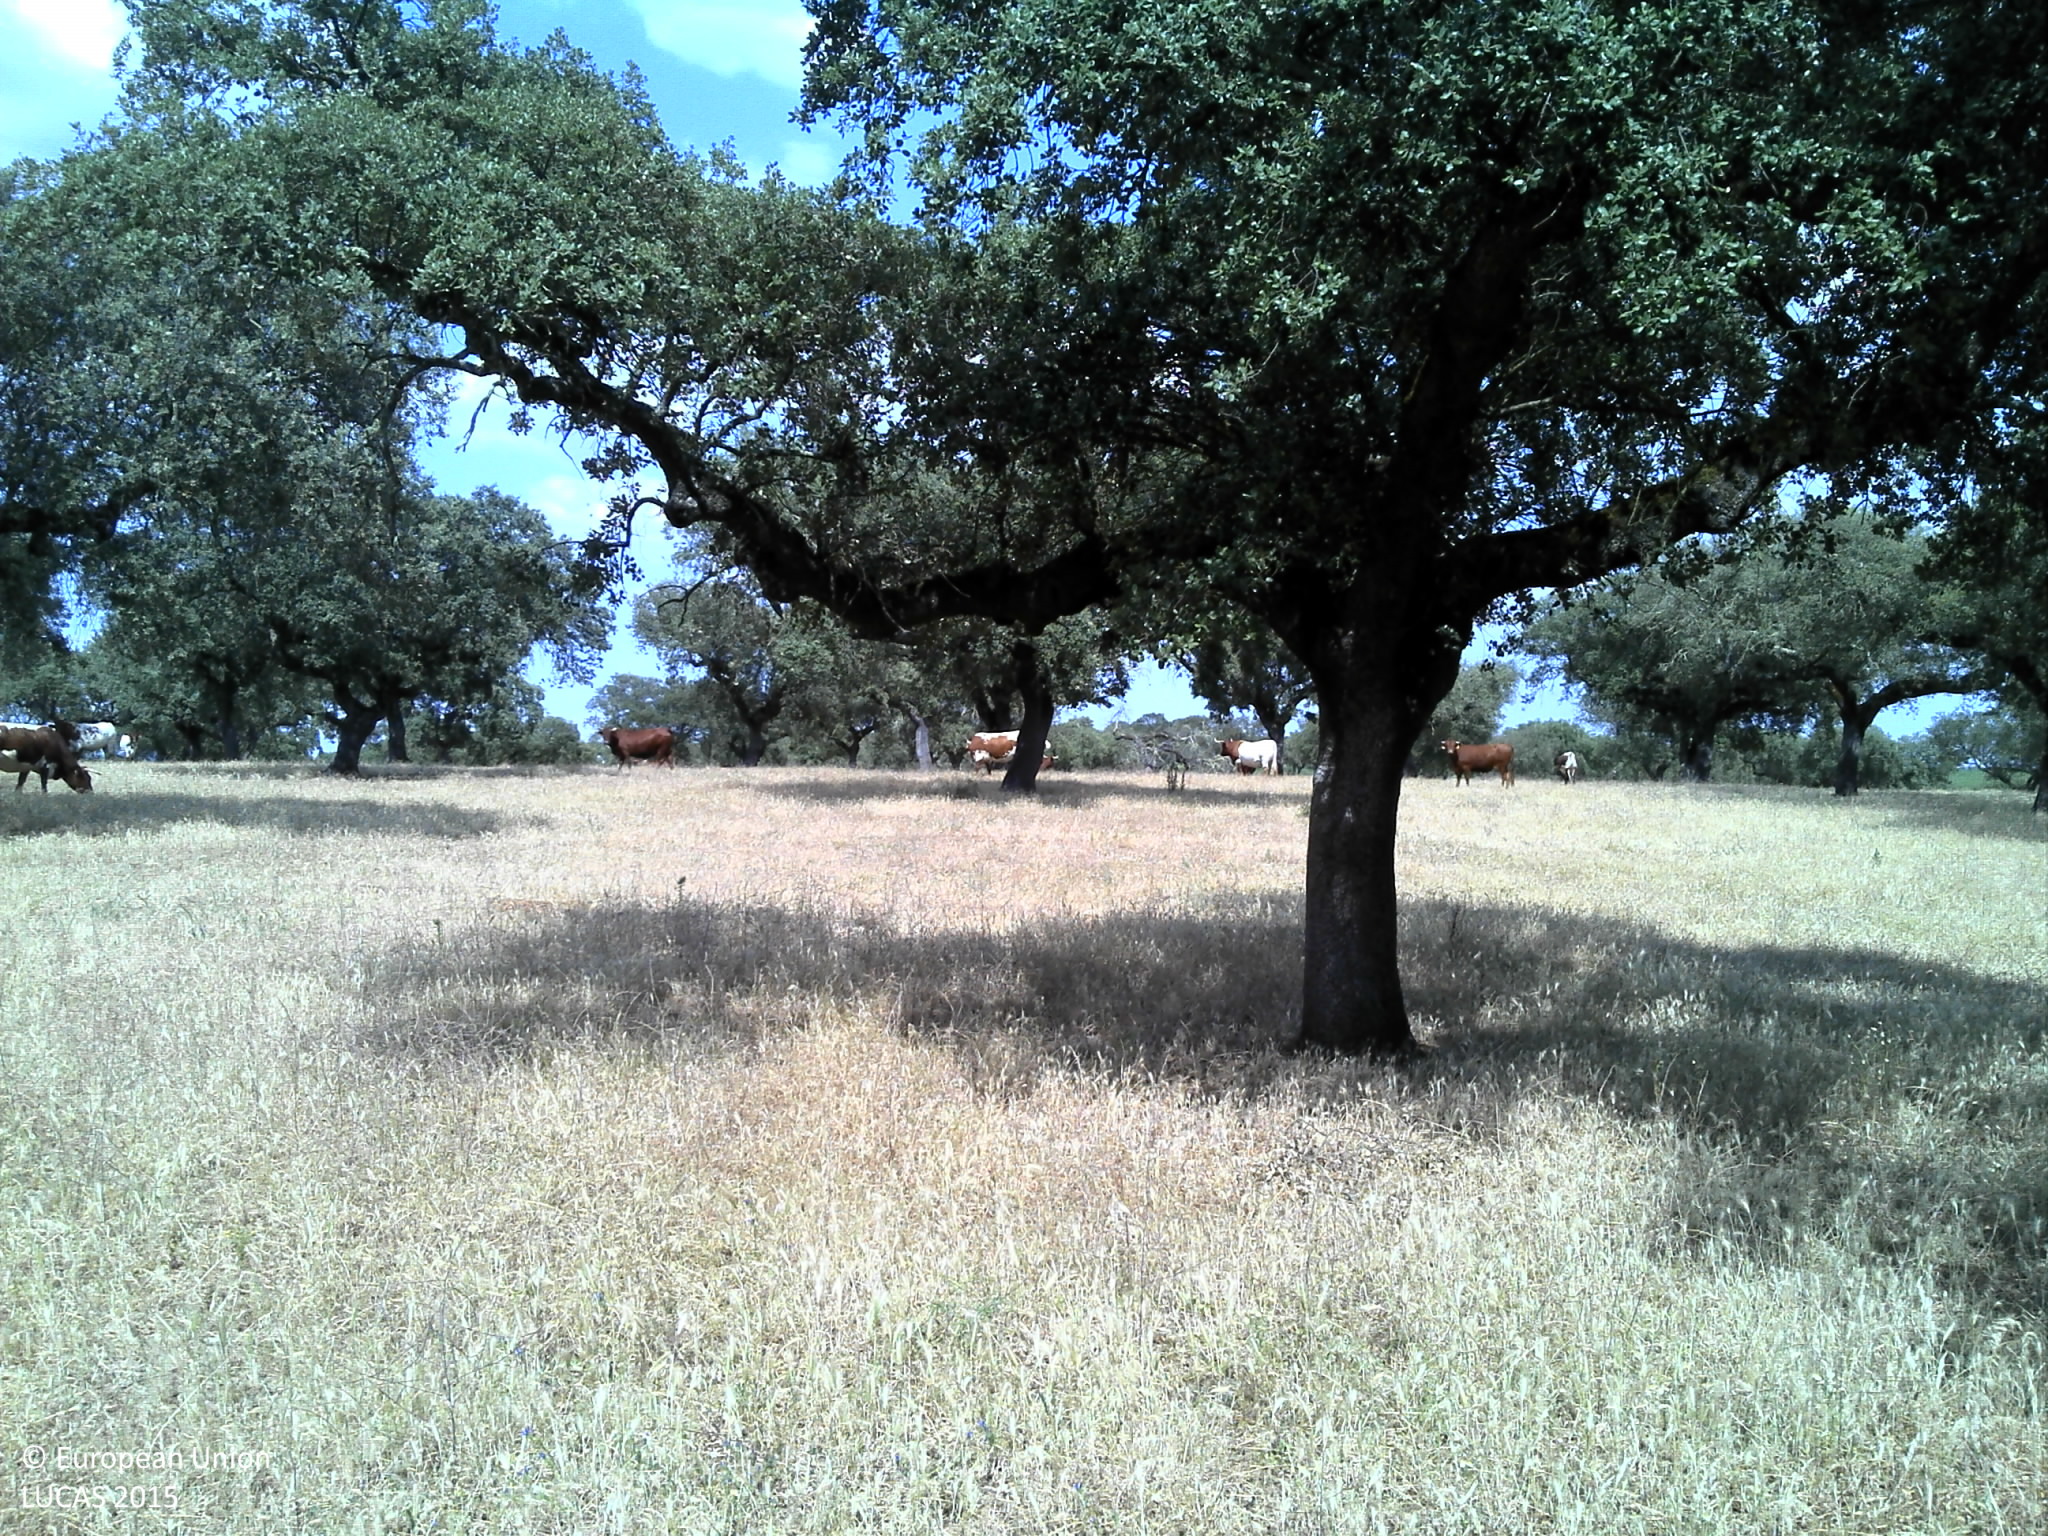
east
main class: Woodland
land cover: Broadleaved woodland
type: broadleaved evergreen forest
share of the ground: 25 - 50 %
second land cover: Grassland without tree/shrub cover
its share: 25 - 50 %
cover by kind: unconsolidated bare surface 40 %, broadleaved forest trees 30 %, herbaceous plants 30 %
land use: Forestry
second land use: Agriculture (excluding fallow land and kitchen gardens)
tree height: > 5 m
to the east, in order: Broadleaved woodland; Grassland without tree/shrub cover; Broadleaved woodland; Tracks; Broadleaved woodland
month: May
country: PT
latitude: 38.8561
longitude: -7.8470
